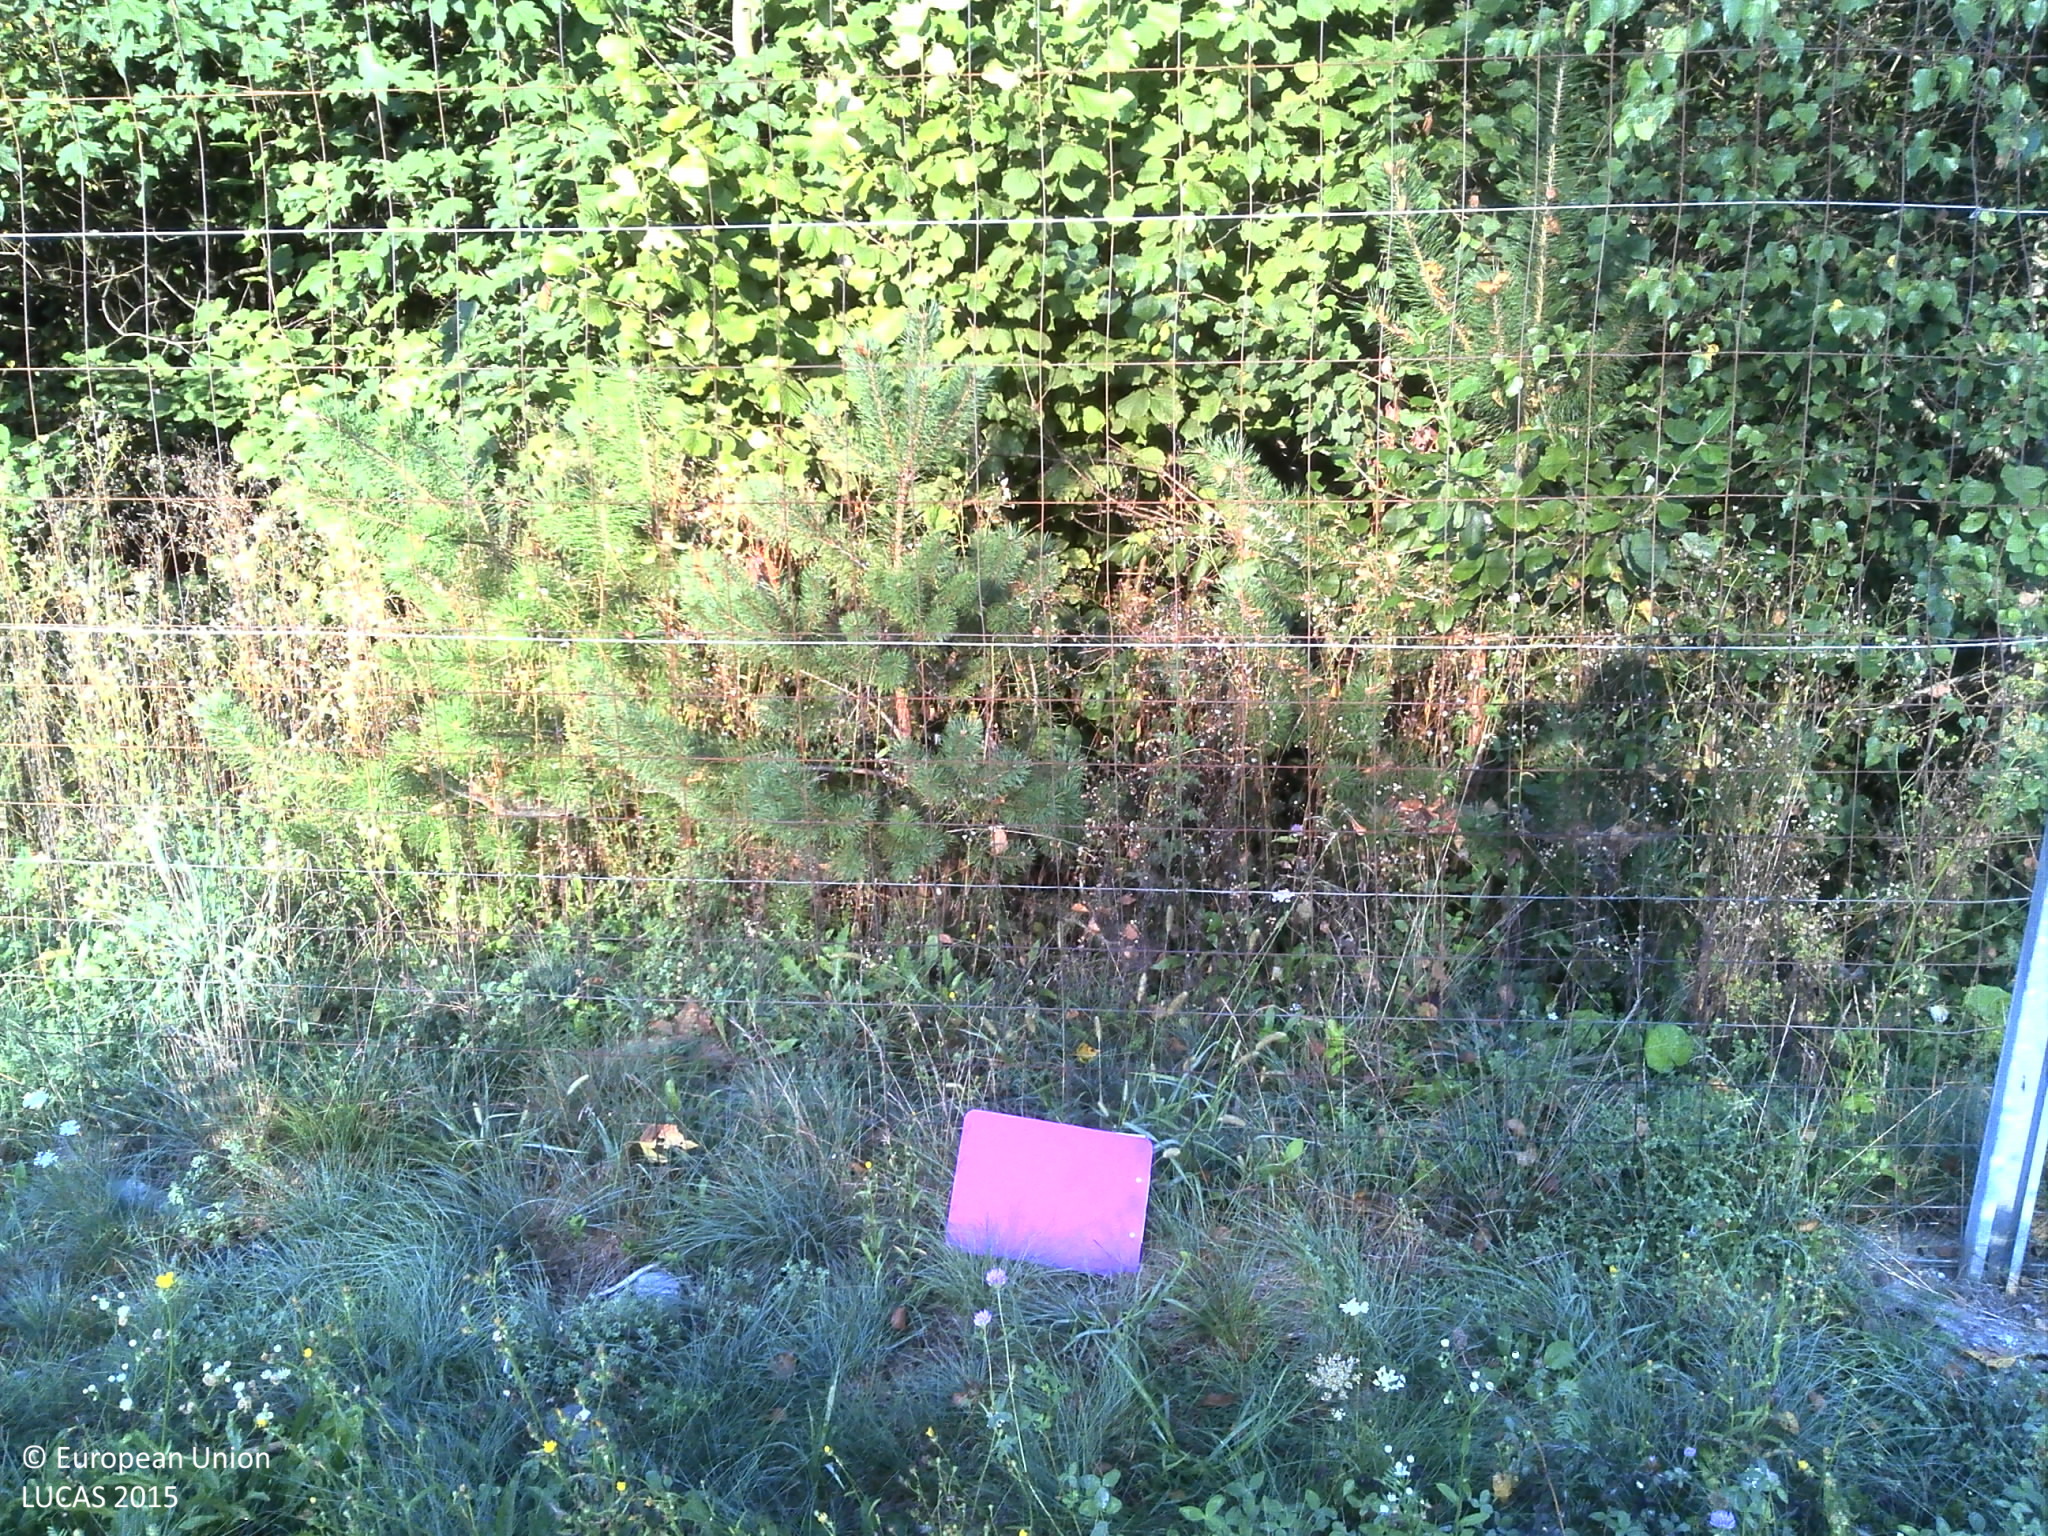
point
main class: Grassland
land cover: Spontaneously vegetated surfaces
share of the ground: > 75 %
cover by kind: herbaceous plants 100 %
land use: Road transport
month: September
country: HR
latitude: 45.3728
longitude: 15.2692
